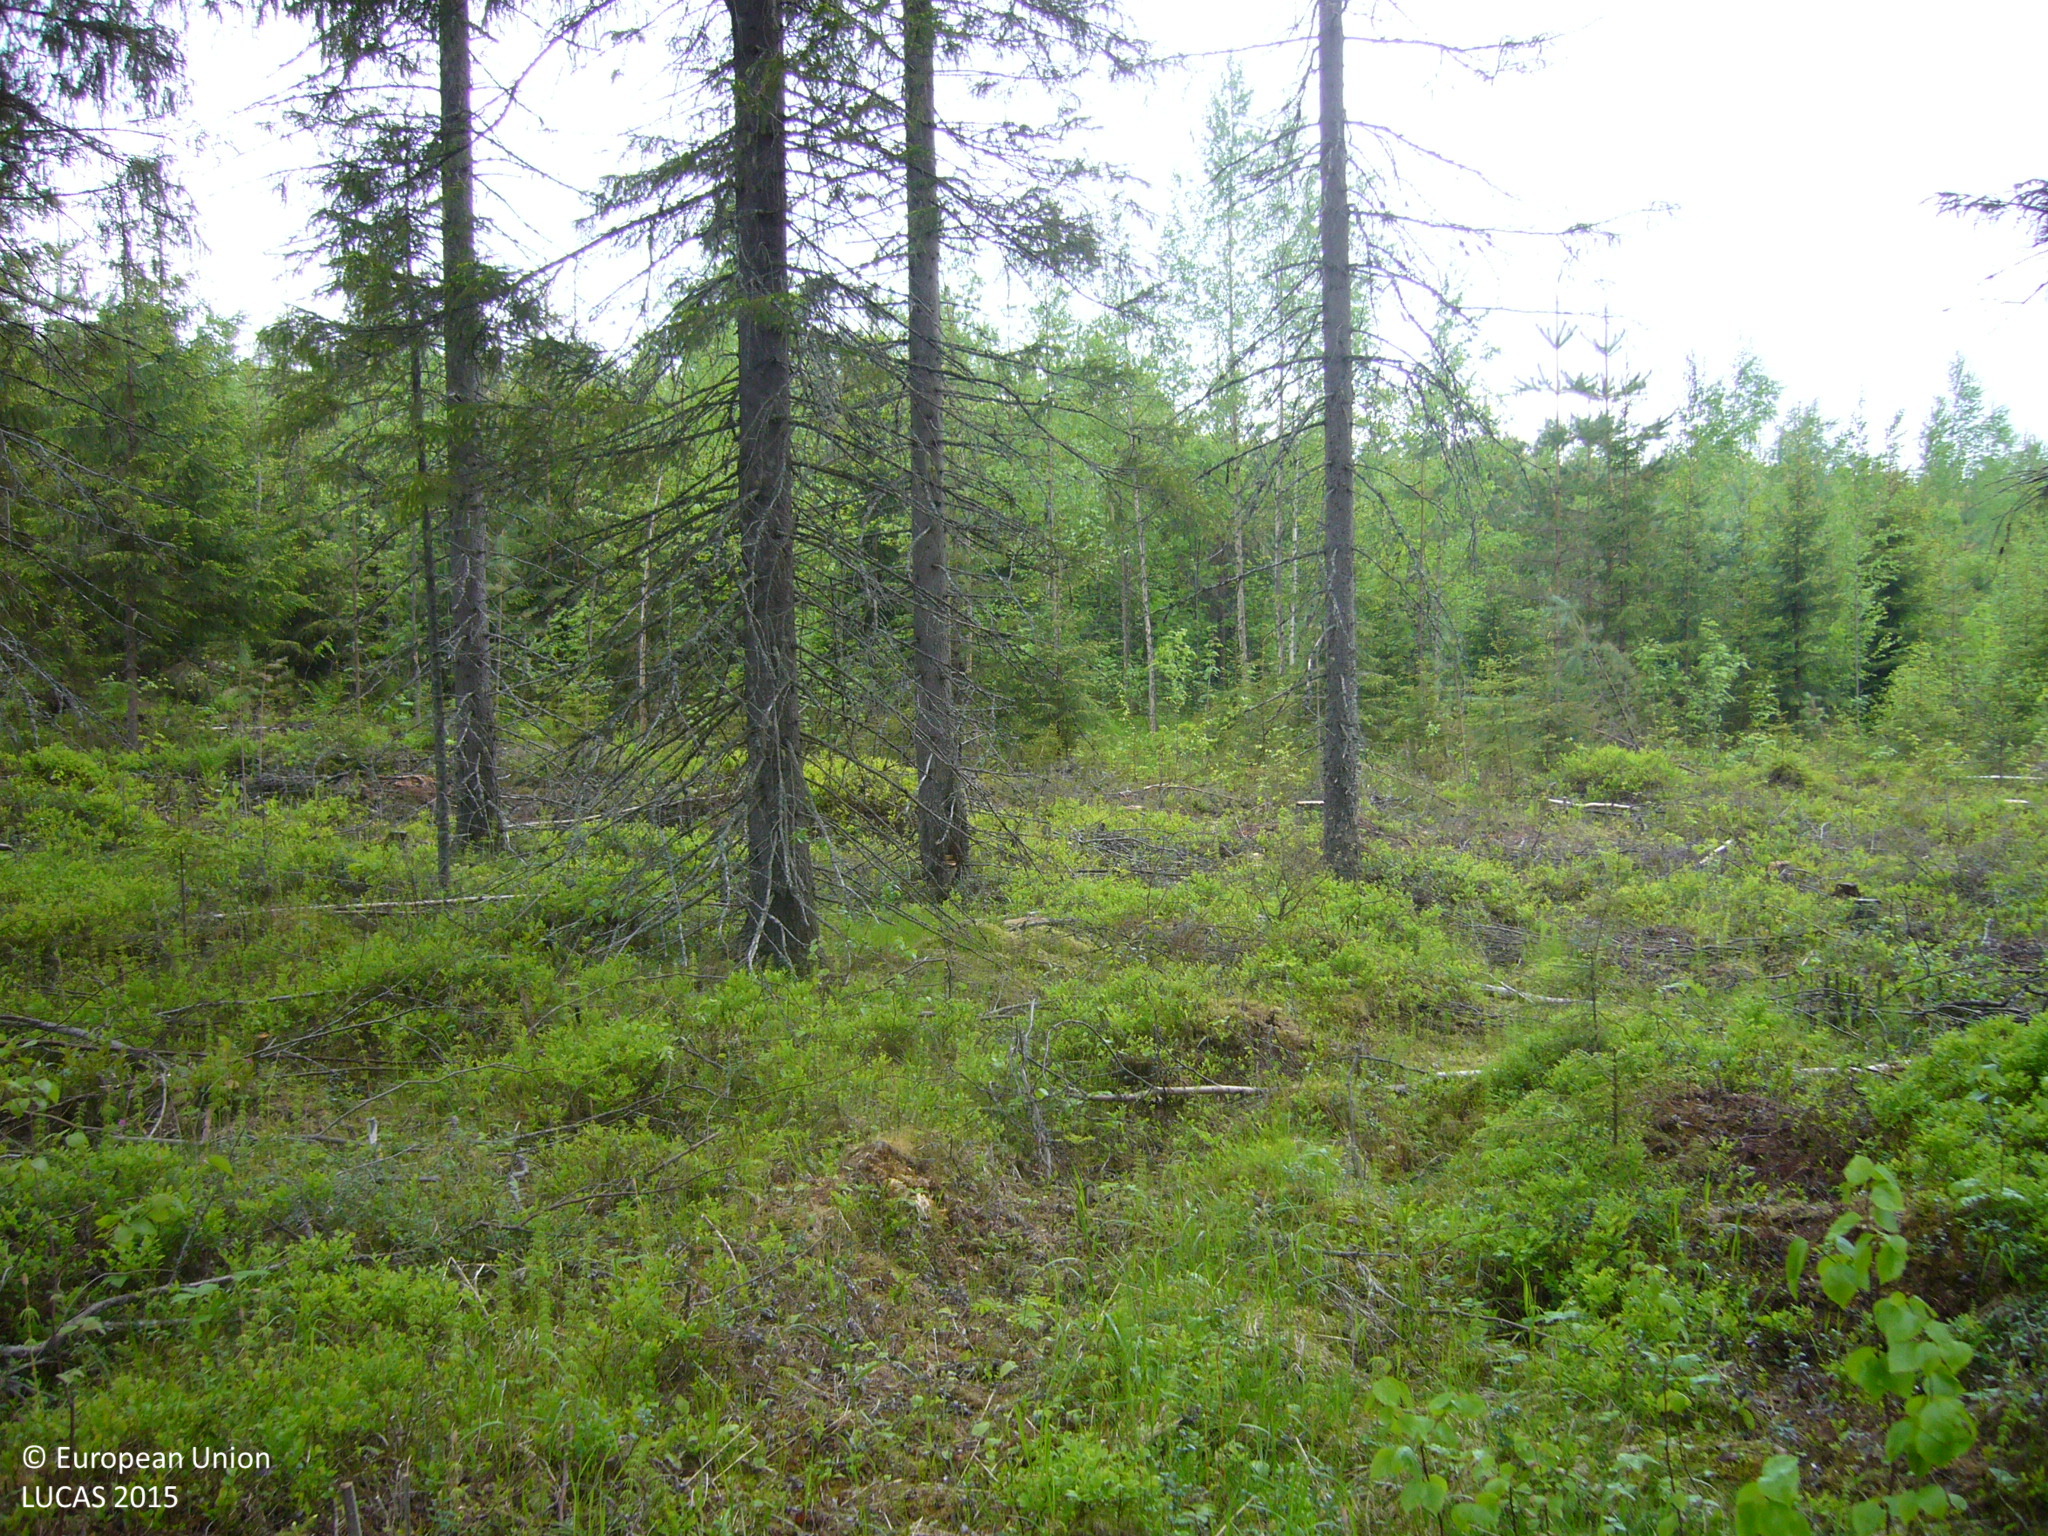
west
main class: Woodland
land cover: Spruce dominated coniferous woodland
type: boreal forest
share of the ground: 50 - 75 %
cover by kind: coniferous forest trees 60 %, shrubs 40 %
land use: Forestry
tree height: > 5 m
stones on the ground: 25 - 50 %
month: June
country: FI
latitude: 63.2326
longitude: 26.6321
